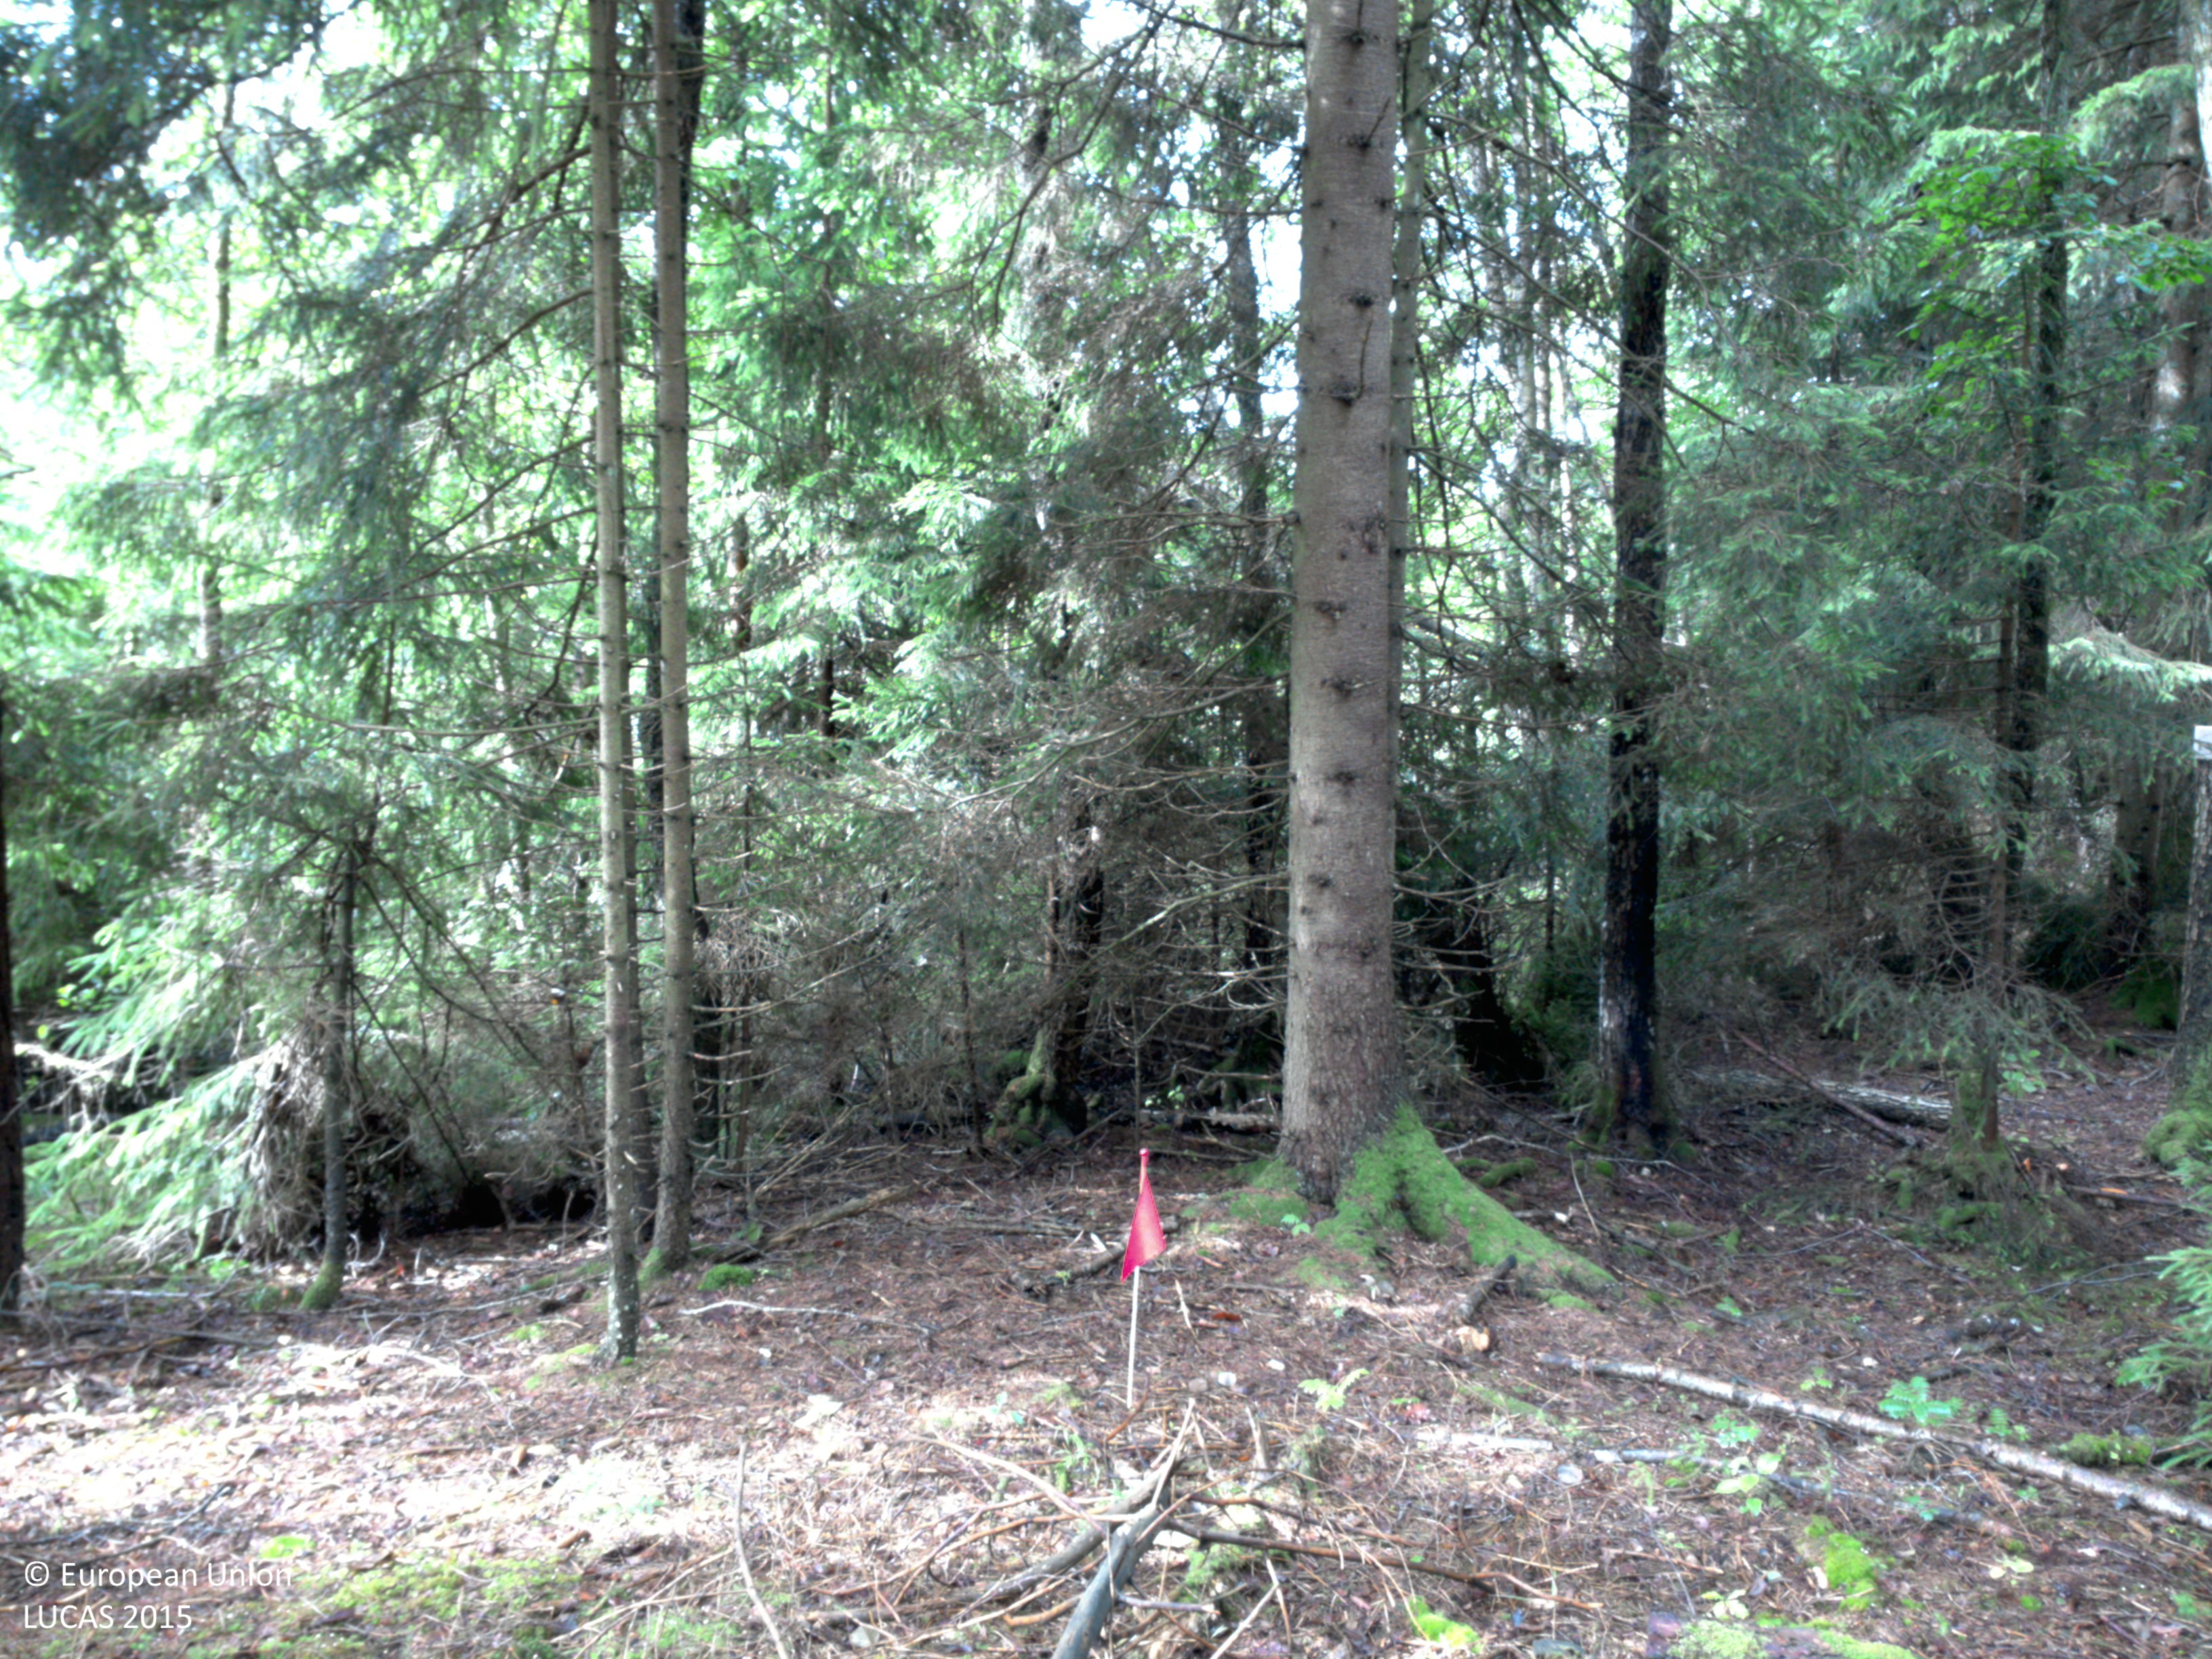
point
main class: Woodland
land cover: Spruce dominated coniferous woodland
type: boreal forest
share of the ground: 50 - 75 %
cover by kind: coniferous forest trees 50 %, consolidated bare surface 20 %, herbaceous plants 15 %, lichens and mosses 15 %
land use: Forestry
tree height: > 5 m
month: July
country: SE
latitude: 58.2392
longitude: 12.0910
